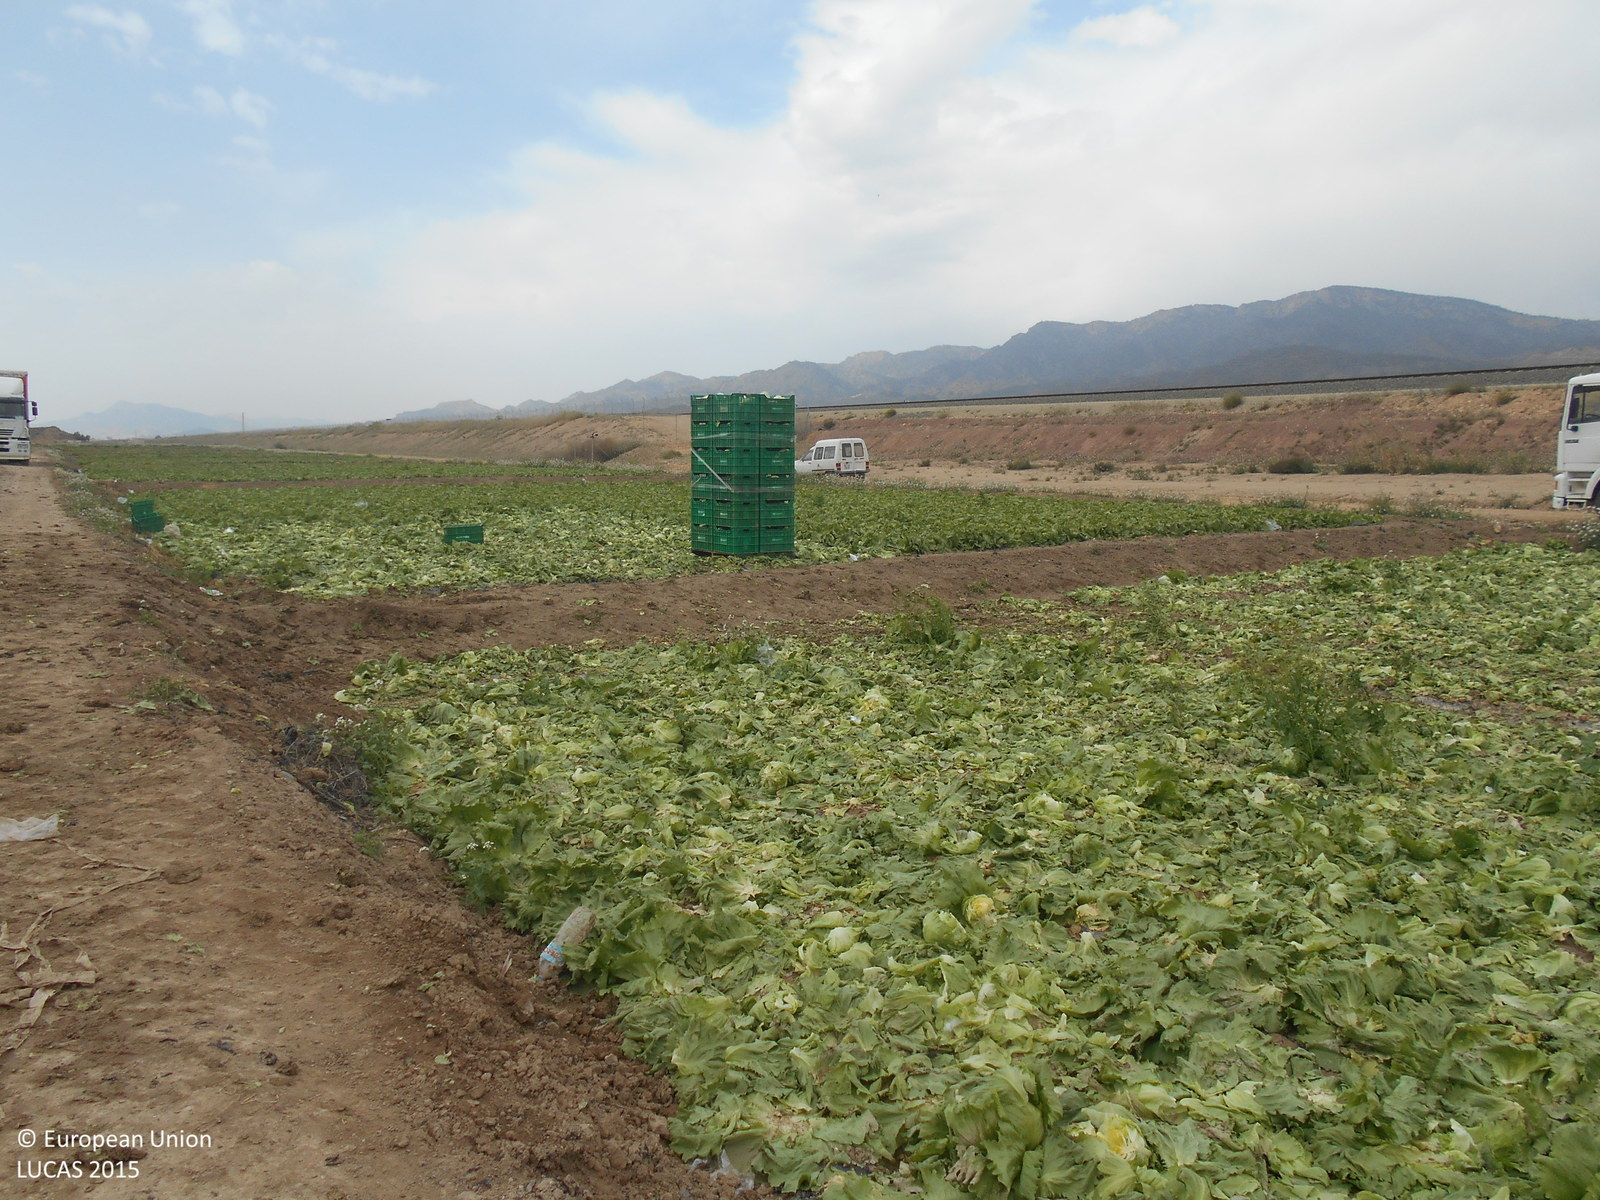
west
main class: Cropland
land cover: Other fresh vegetables
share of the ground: > 75 %
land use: Agriculture (excluding fallow land and kitchen gardens)
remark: Harvested field
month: April
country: ES
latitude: 37.7193
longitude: -1.5428
